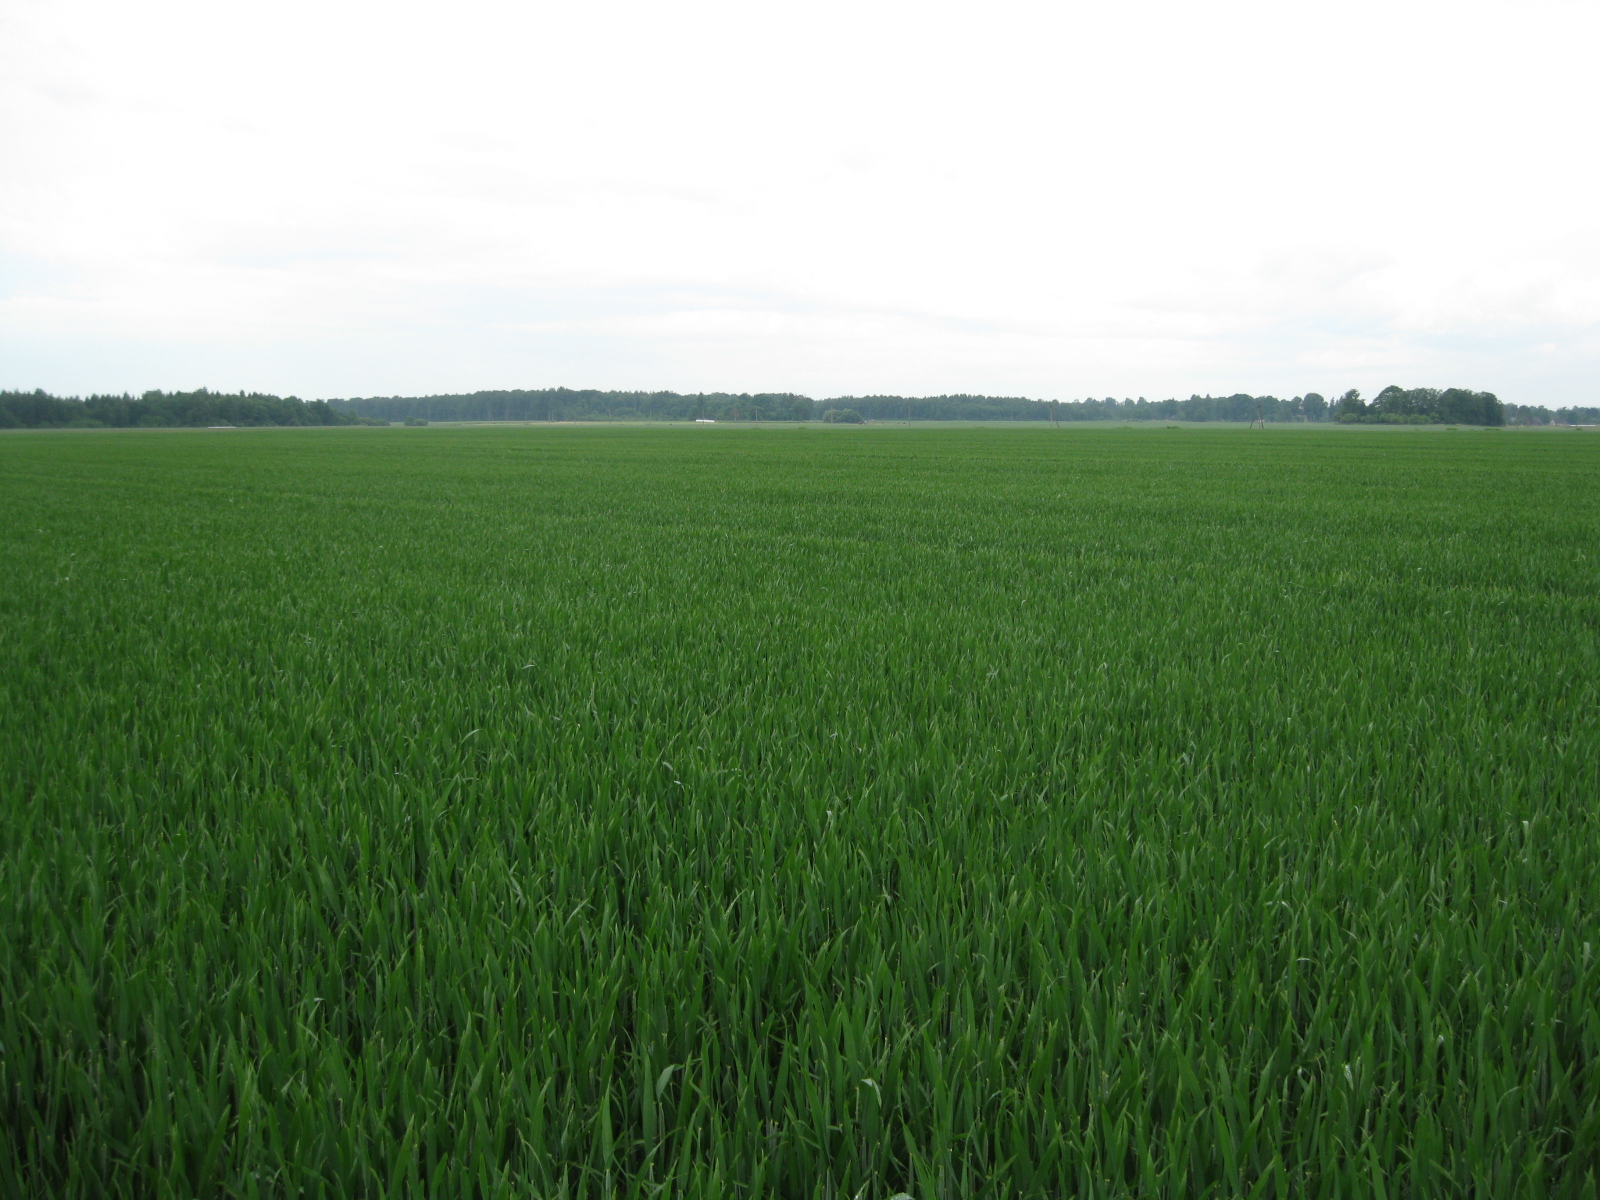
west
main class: Cropland
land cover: Common wheat
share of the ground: > 75 %
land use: Agriculture (excluding fallow land and kitchen gardens)
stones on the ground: < 10 %
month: June
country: LT
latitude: 55.6322
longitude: 24.0194
